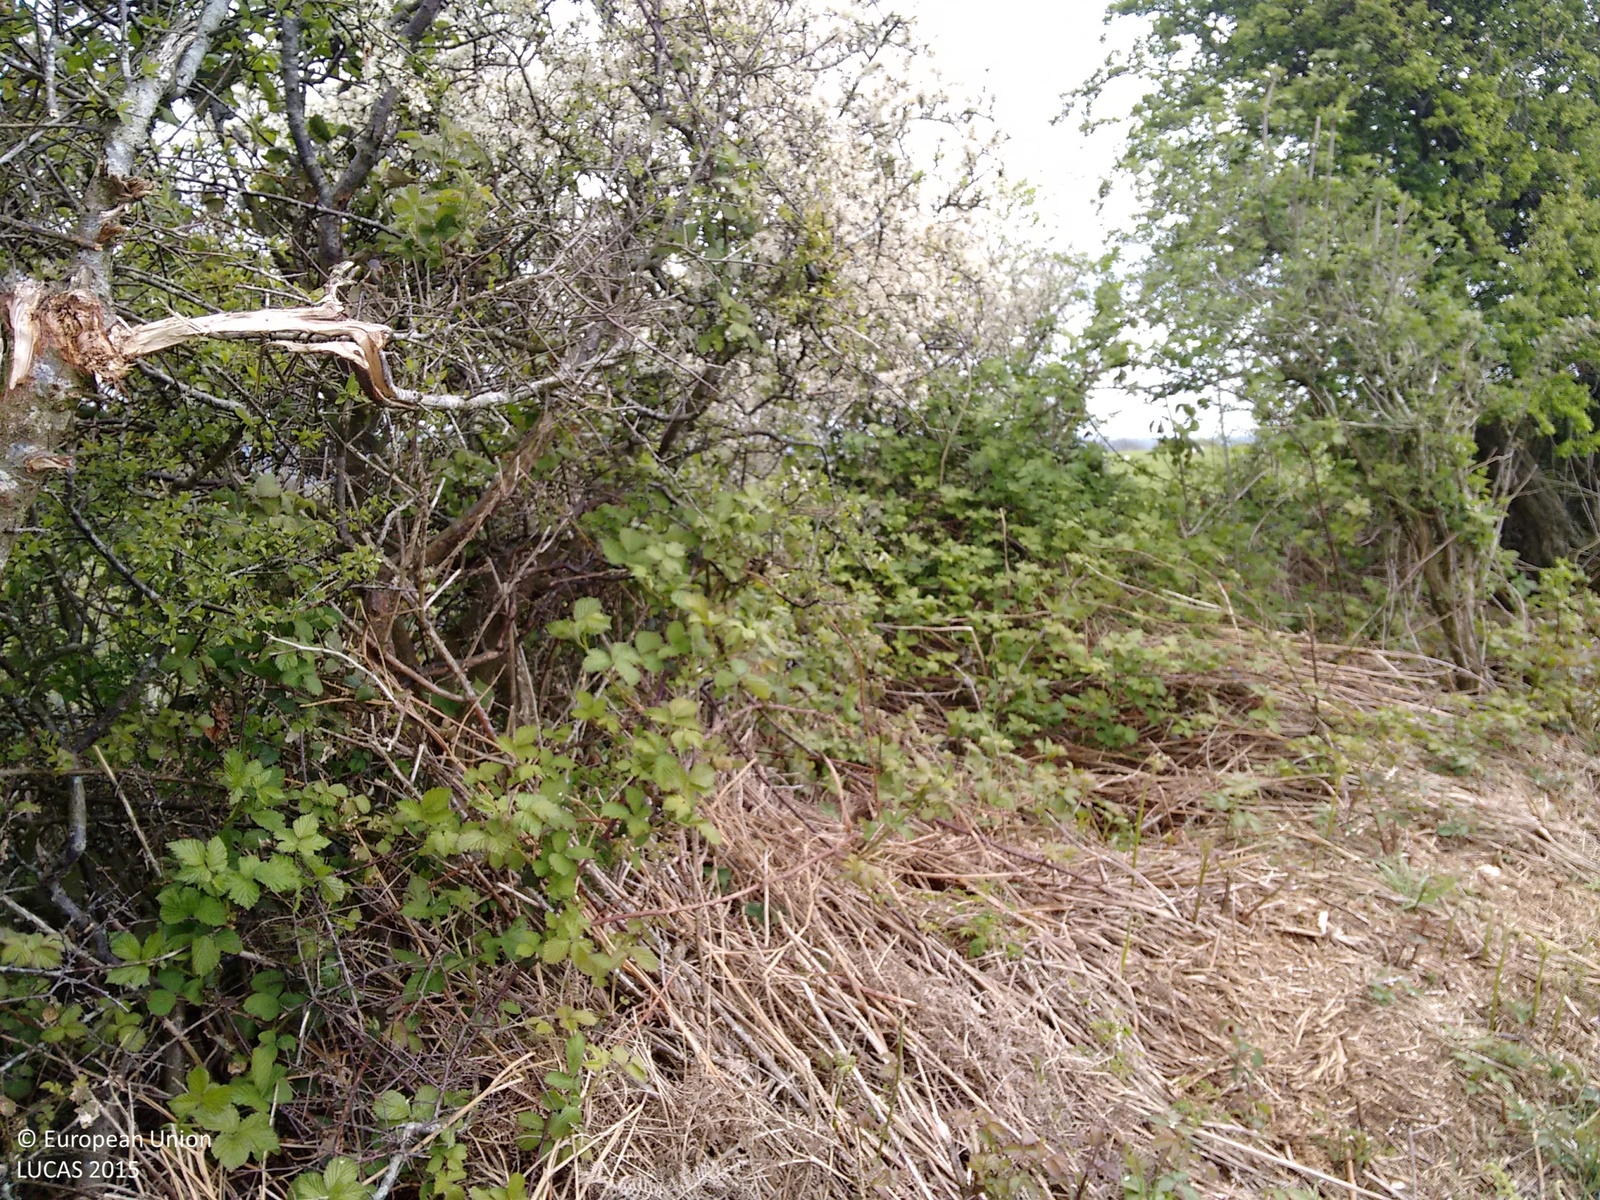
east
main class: Shrubland
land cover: Shrubland with sparse tree cover
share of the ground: > 75 %
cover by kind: shrubs 95 %, broadleaved forest trees 5 %
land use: Agriculture (excluding fallow land and kitchen gardens)
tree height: < 5 m
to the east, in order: Shrubland with sparse tree cover; Fences; Grassland without tree/shrub cover; Fences; Grassland without tree/shrub cover
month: May
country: GB
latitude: 51.0697
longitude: -0.9613
